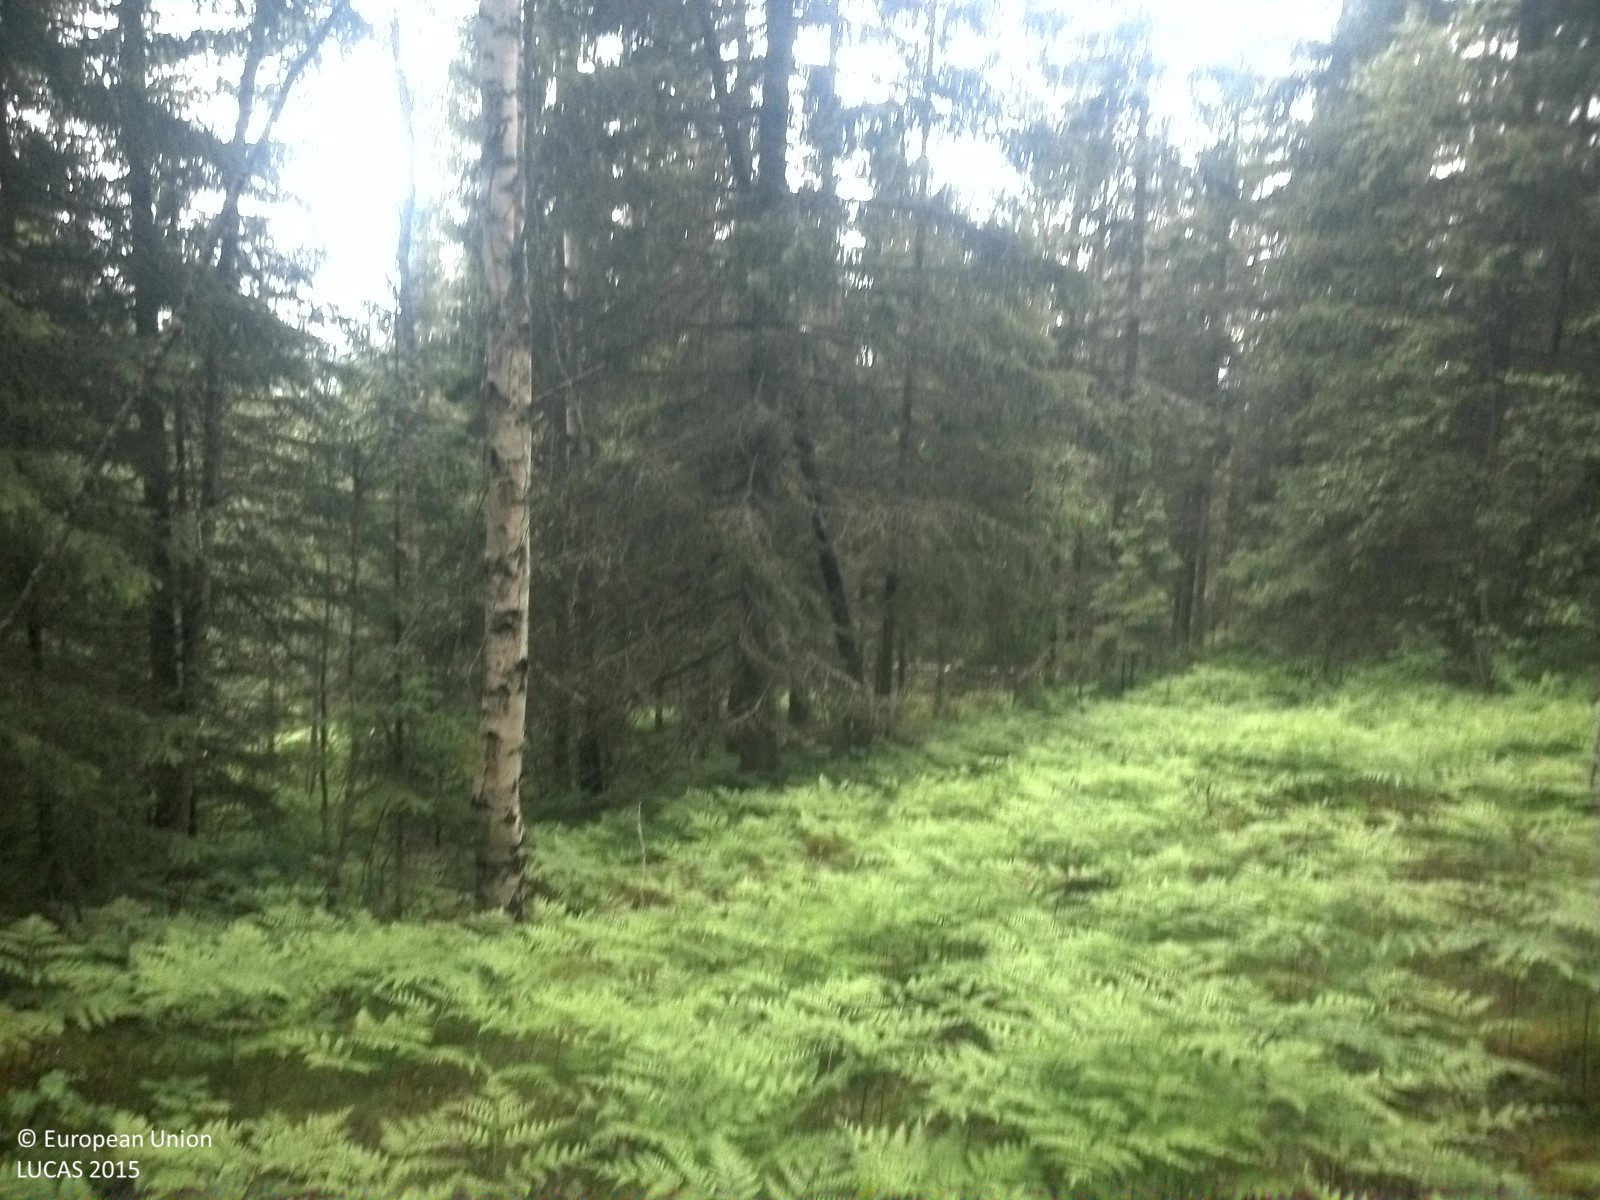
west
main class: Woodland
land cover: Spruce dominated mixed woodland
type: boreal forest
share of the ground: 50 - 75 %
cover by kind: coniferous forest trees 45 %, broadleaved forest trees 25 %, herbaceous plants 15 %, lichens and mosses 10 %, shrubs 5 %
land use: Forestry
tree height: > 5 m
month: July
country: SE
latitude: 62.5491
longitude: 17.1933
